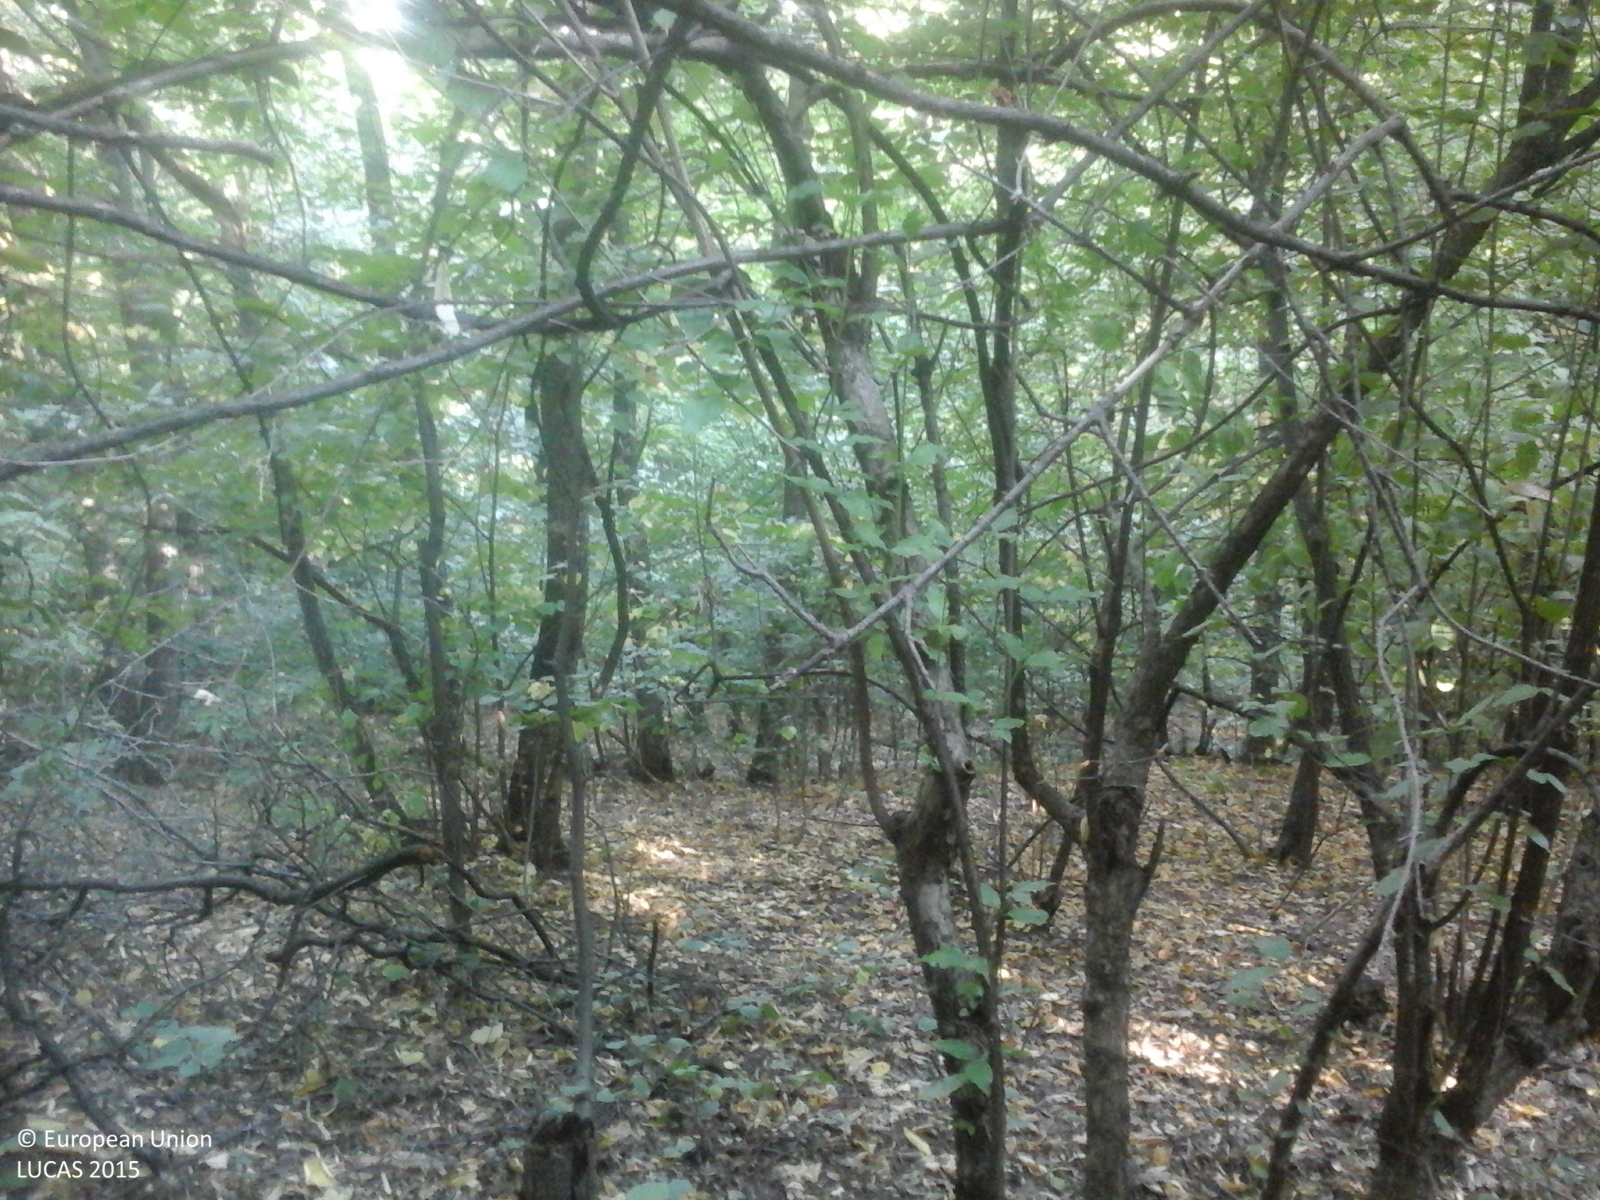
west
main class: Woodland
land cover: Broadleaved woodland
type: mesophytic deciduous forest
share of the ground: > 75 %
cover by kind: broadleaved forest trees 100 %
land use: Forestry
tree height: > 5 m
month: July
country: RO
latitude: 46.2918
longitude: 27.8384
